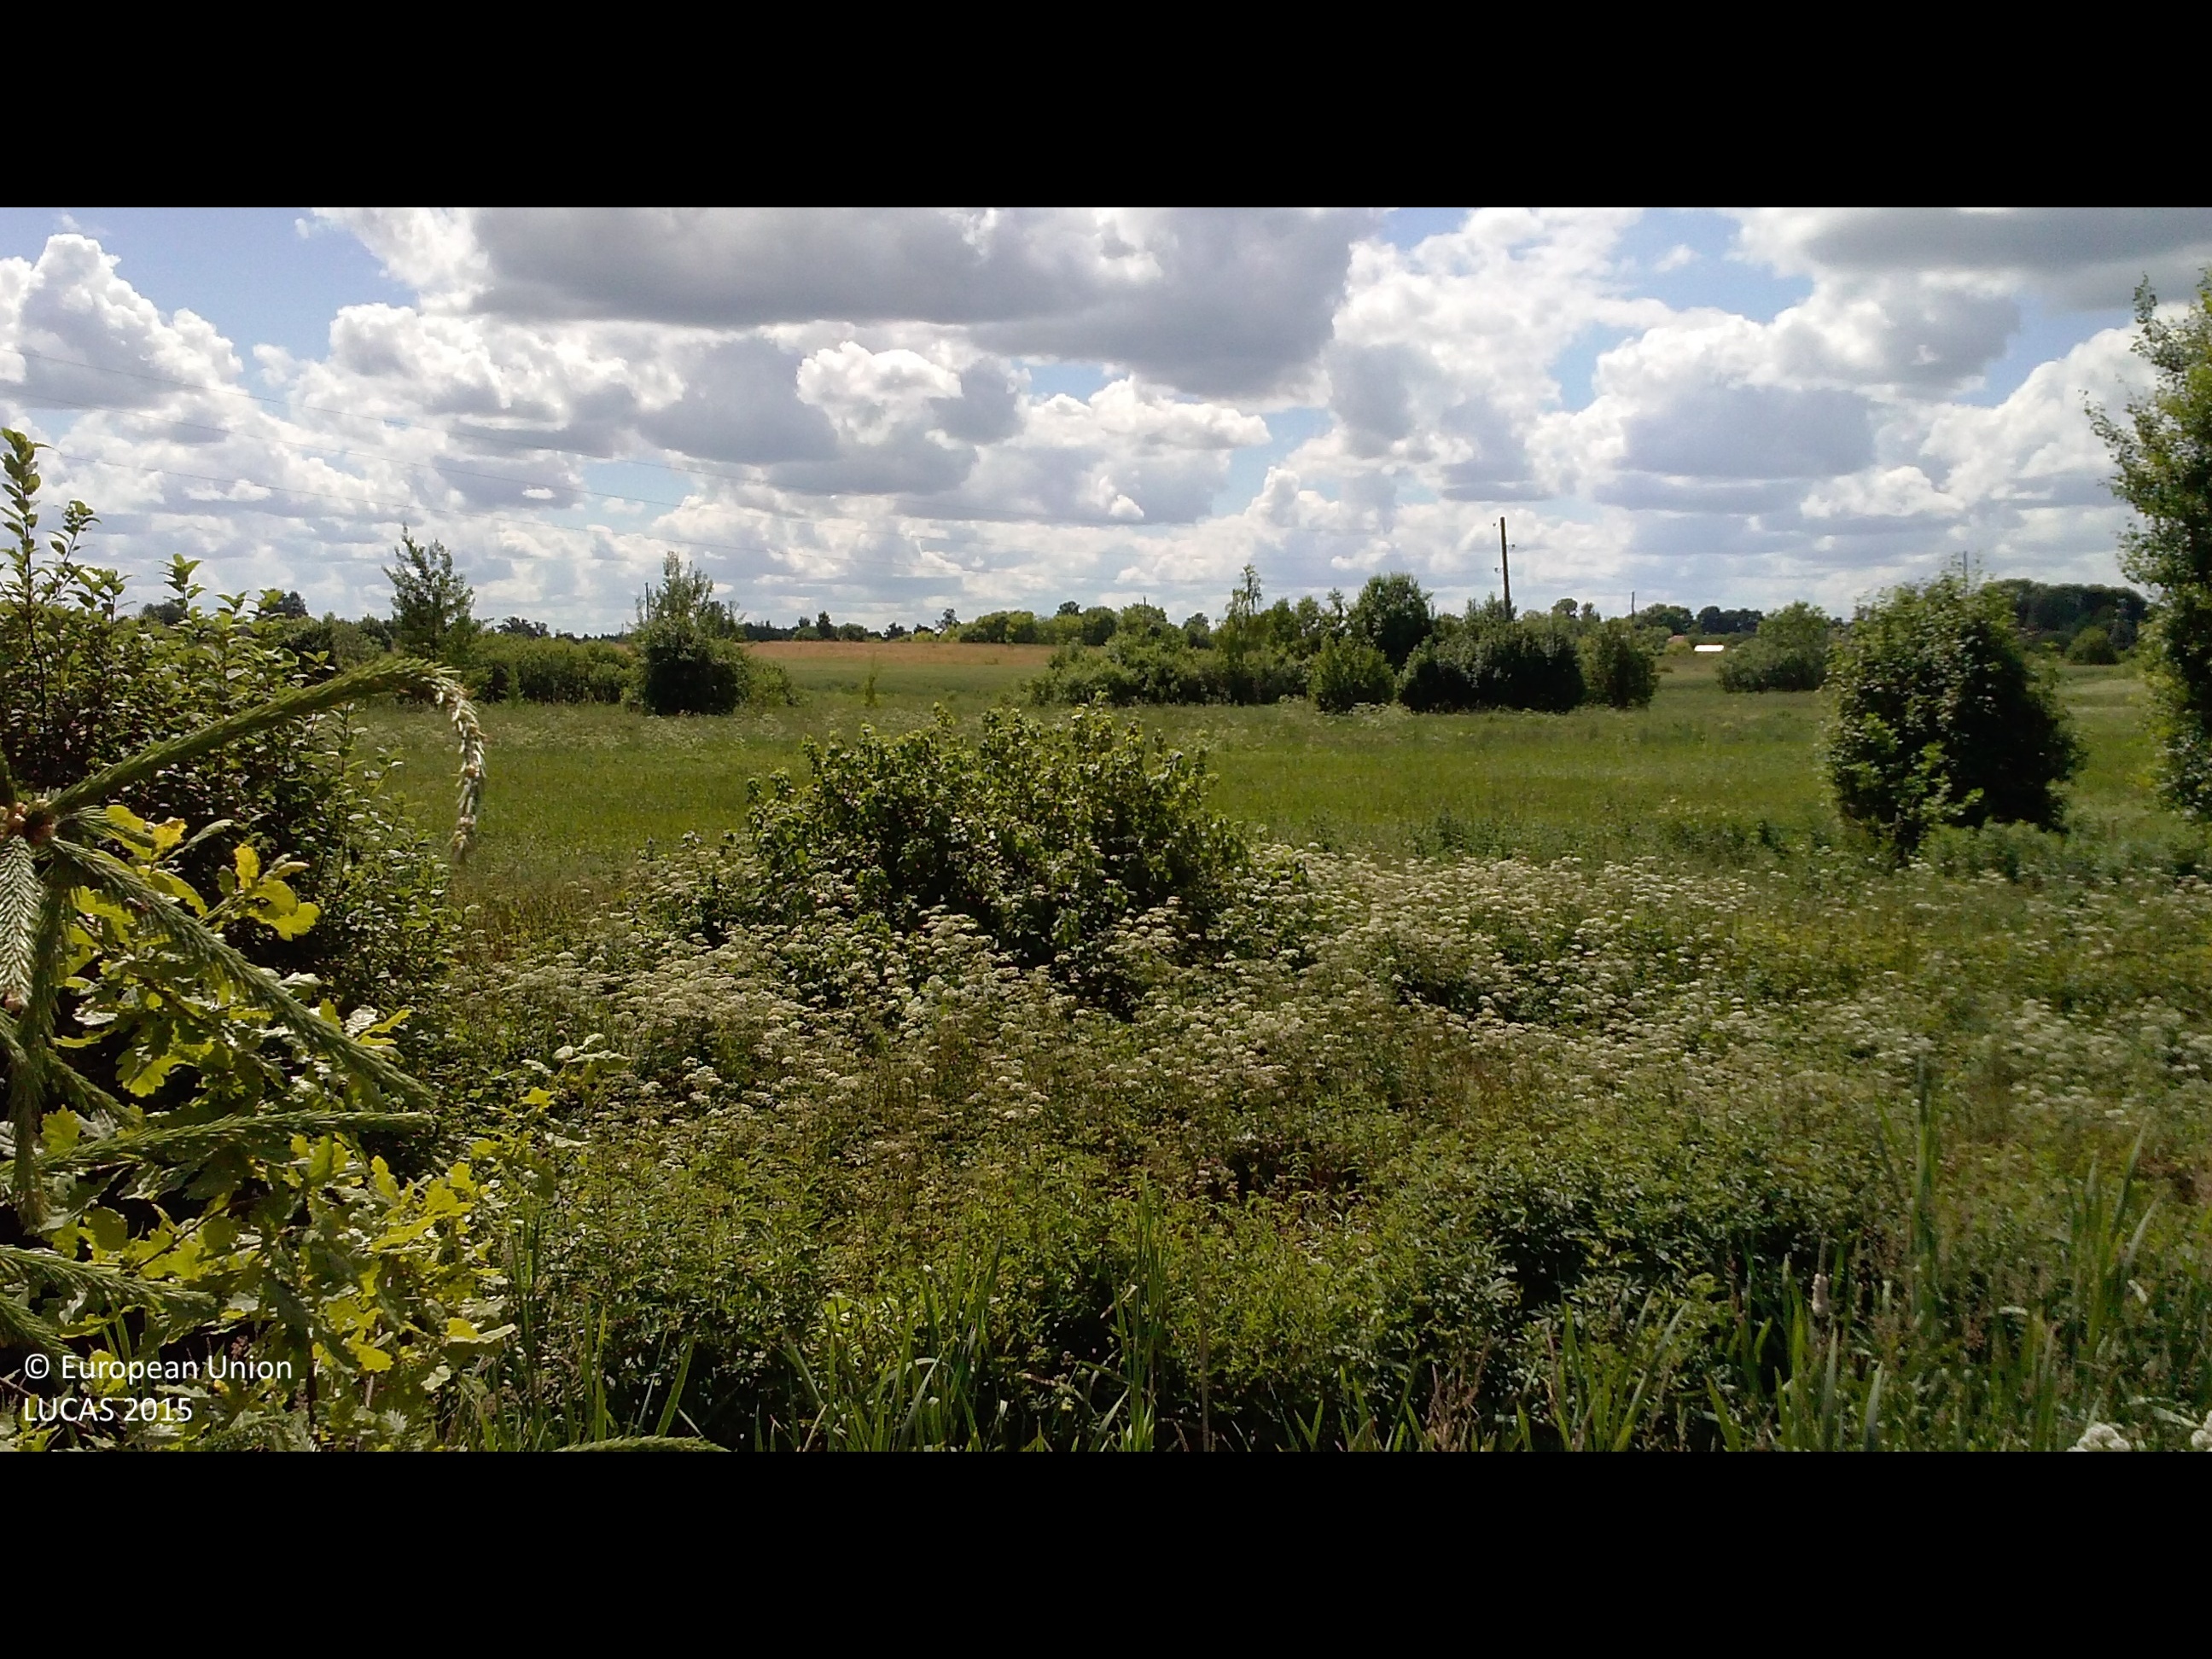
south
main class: Grassland
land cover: Grassland without tree/shrub cover
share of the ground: > 75 %
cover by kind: herbaceous plants 100 %
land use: Agriculture (excluding fallow land and kitchen gardens)
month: June
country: LV
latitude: 56.5438
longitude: 27.7360
